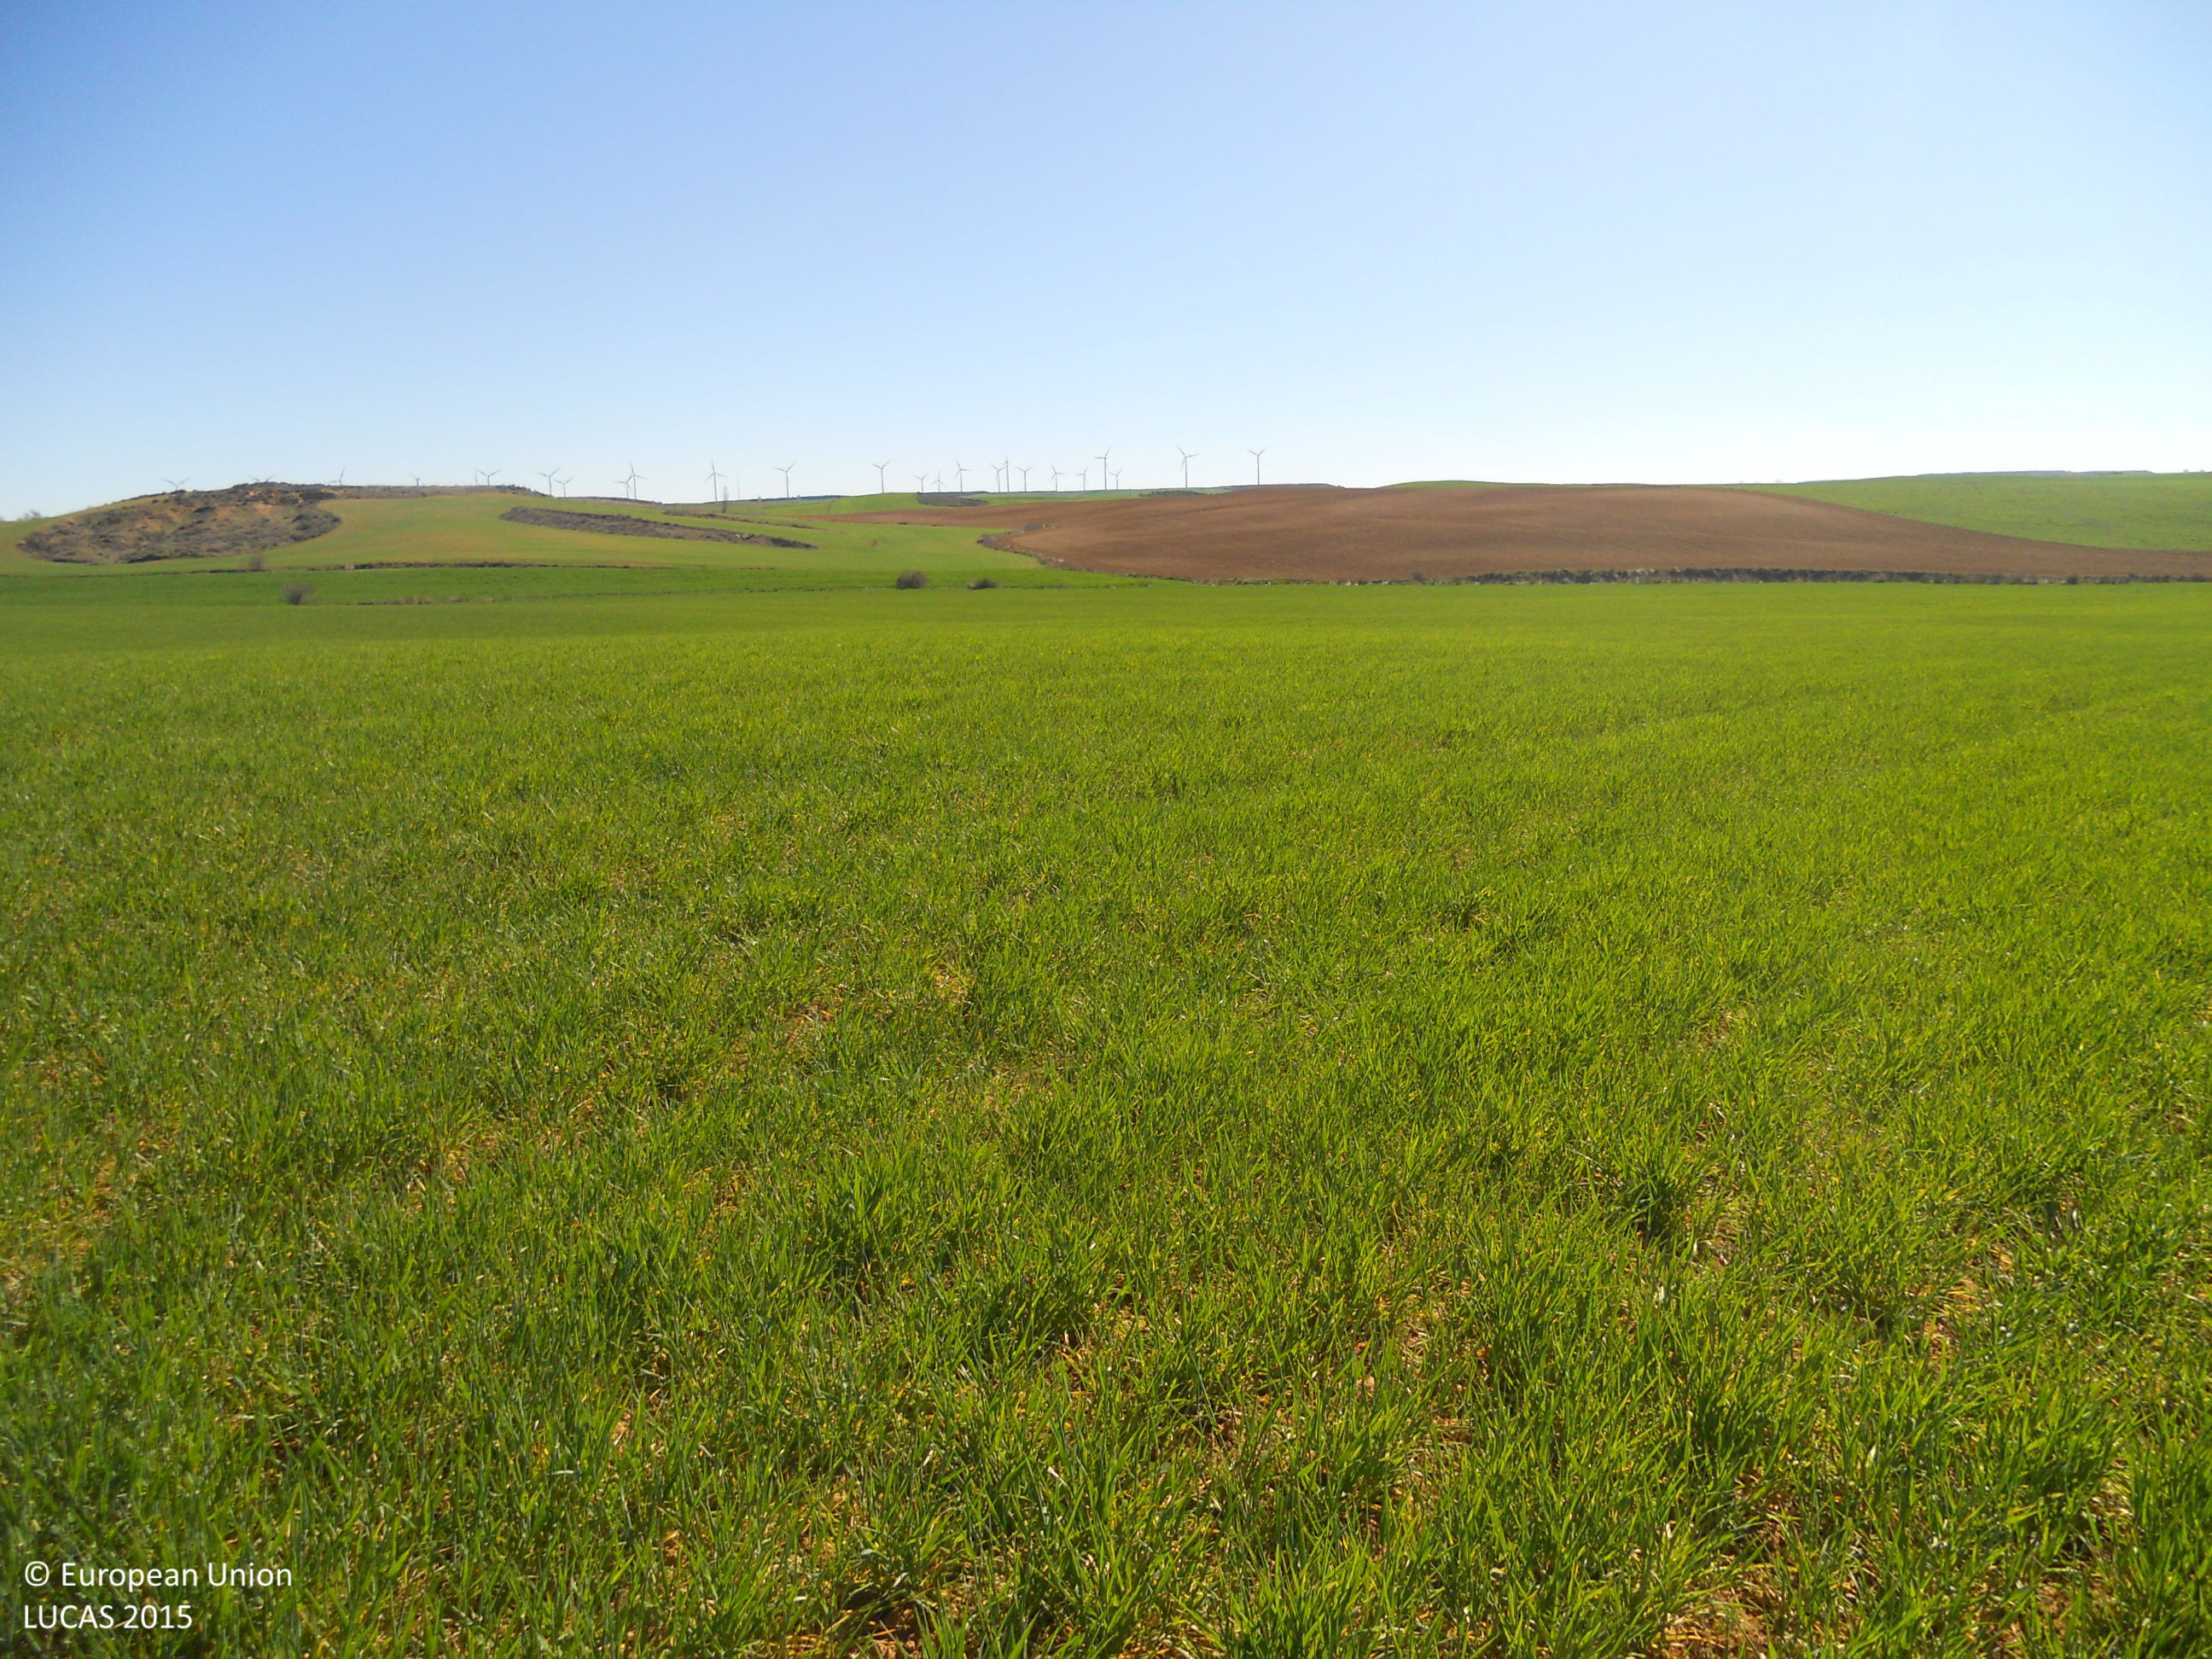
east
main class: Cropland
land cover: Barley
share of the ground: > 75 %
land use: Agriculture (excluding fallow land and kitchen gardens)
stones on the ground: < 10 %
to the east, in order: Barley; Grass margins; Barley; Grassland without tree/shrub cover; Barley; Grass margins; Other bare soil
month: April
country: ES
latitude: 42.2414
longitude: -4.7773
